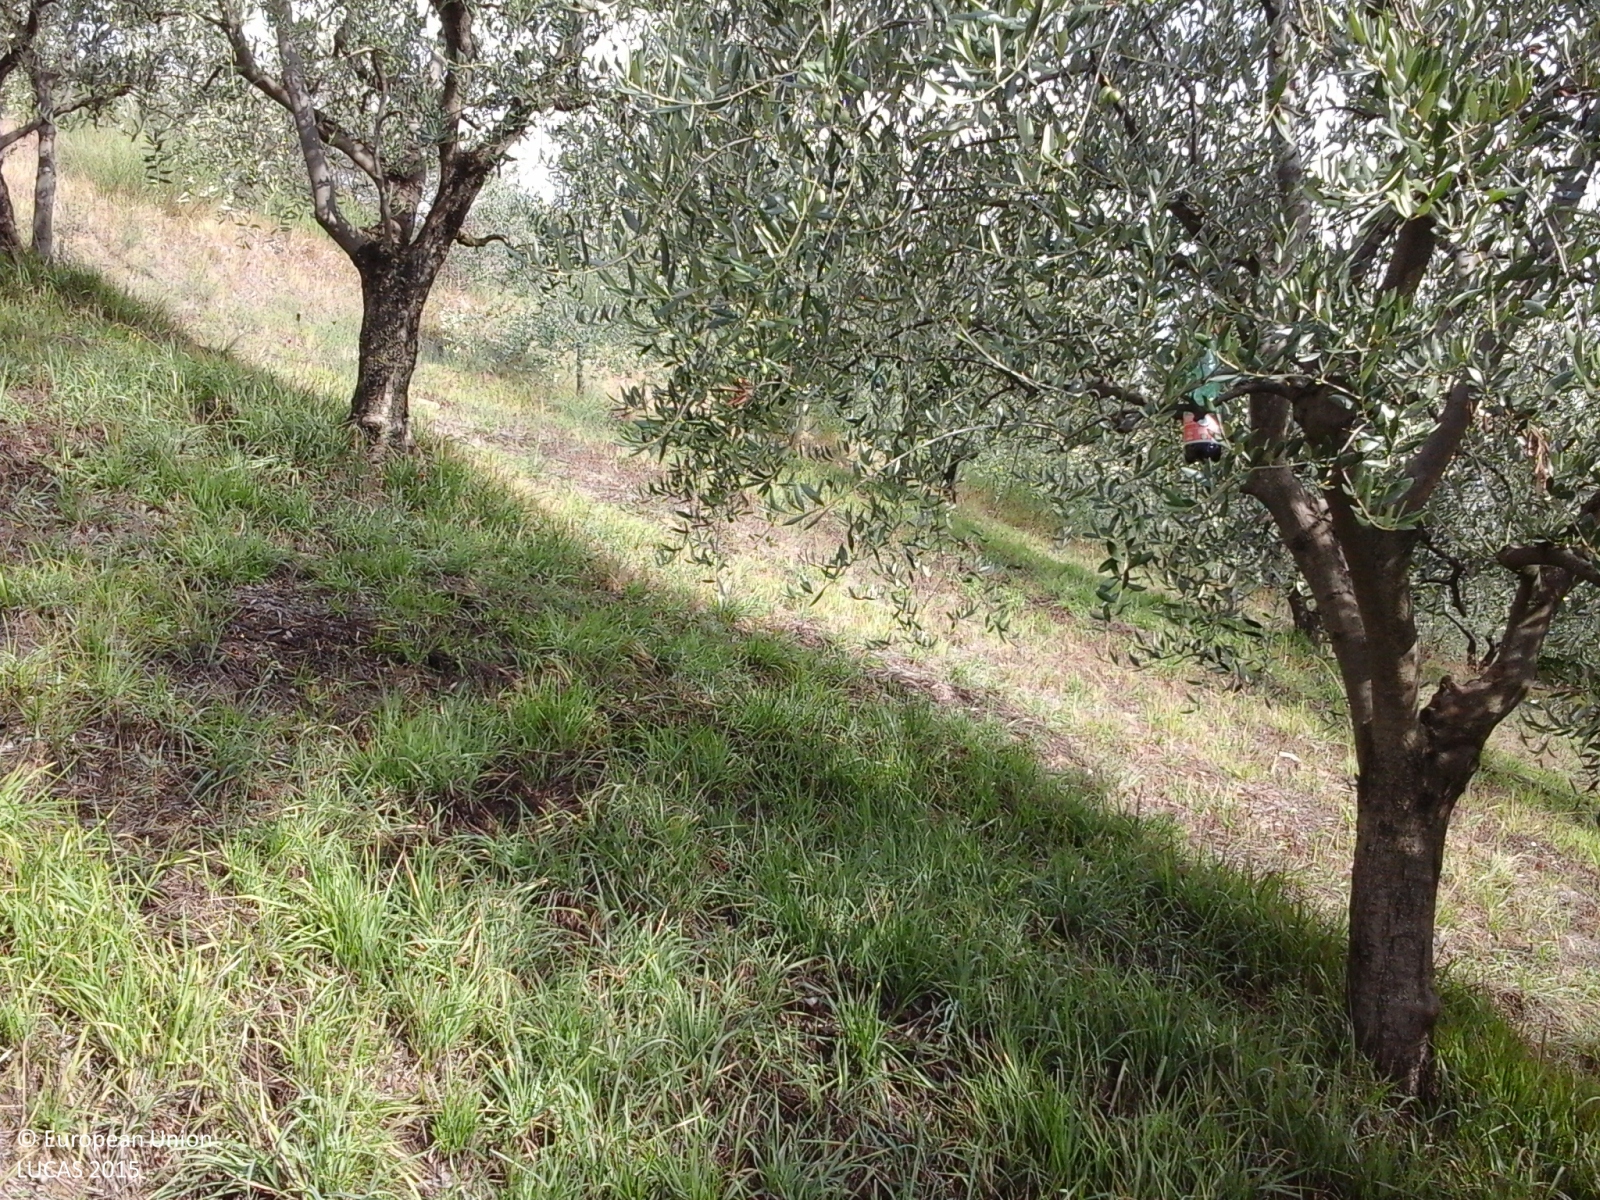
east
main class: Cropland
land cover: Olive groves
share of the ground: 50 - 75 %
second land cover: Spontaneously vegetated surfaces
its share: > 75 %
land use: Agriculture (excluding fallow land and kitchen gardens)
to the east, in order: Olive groves; Spontaneously vegetated surfaces; Shrubland without tree cover; Abandoned hedges; Tracks; Other bare soil; Shrubland without tree cover; Abandoned hedges; Vineyards
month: October
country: IT
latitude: 43.3247
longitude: 12.6196
